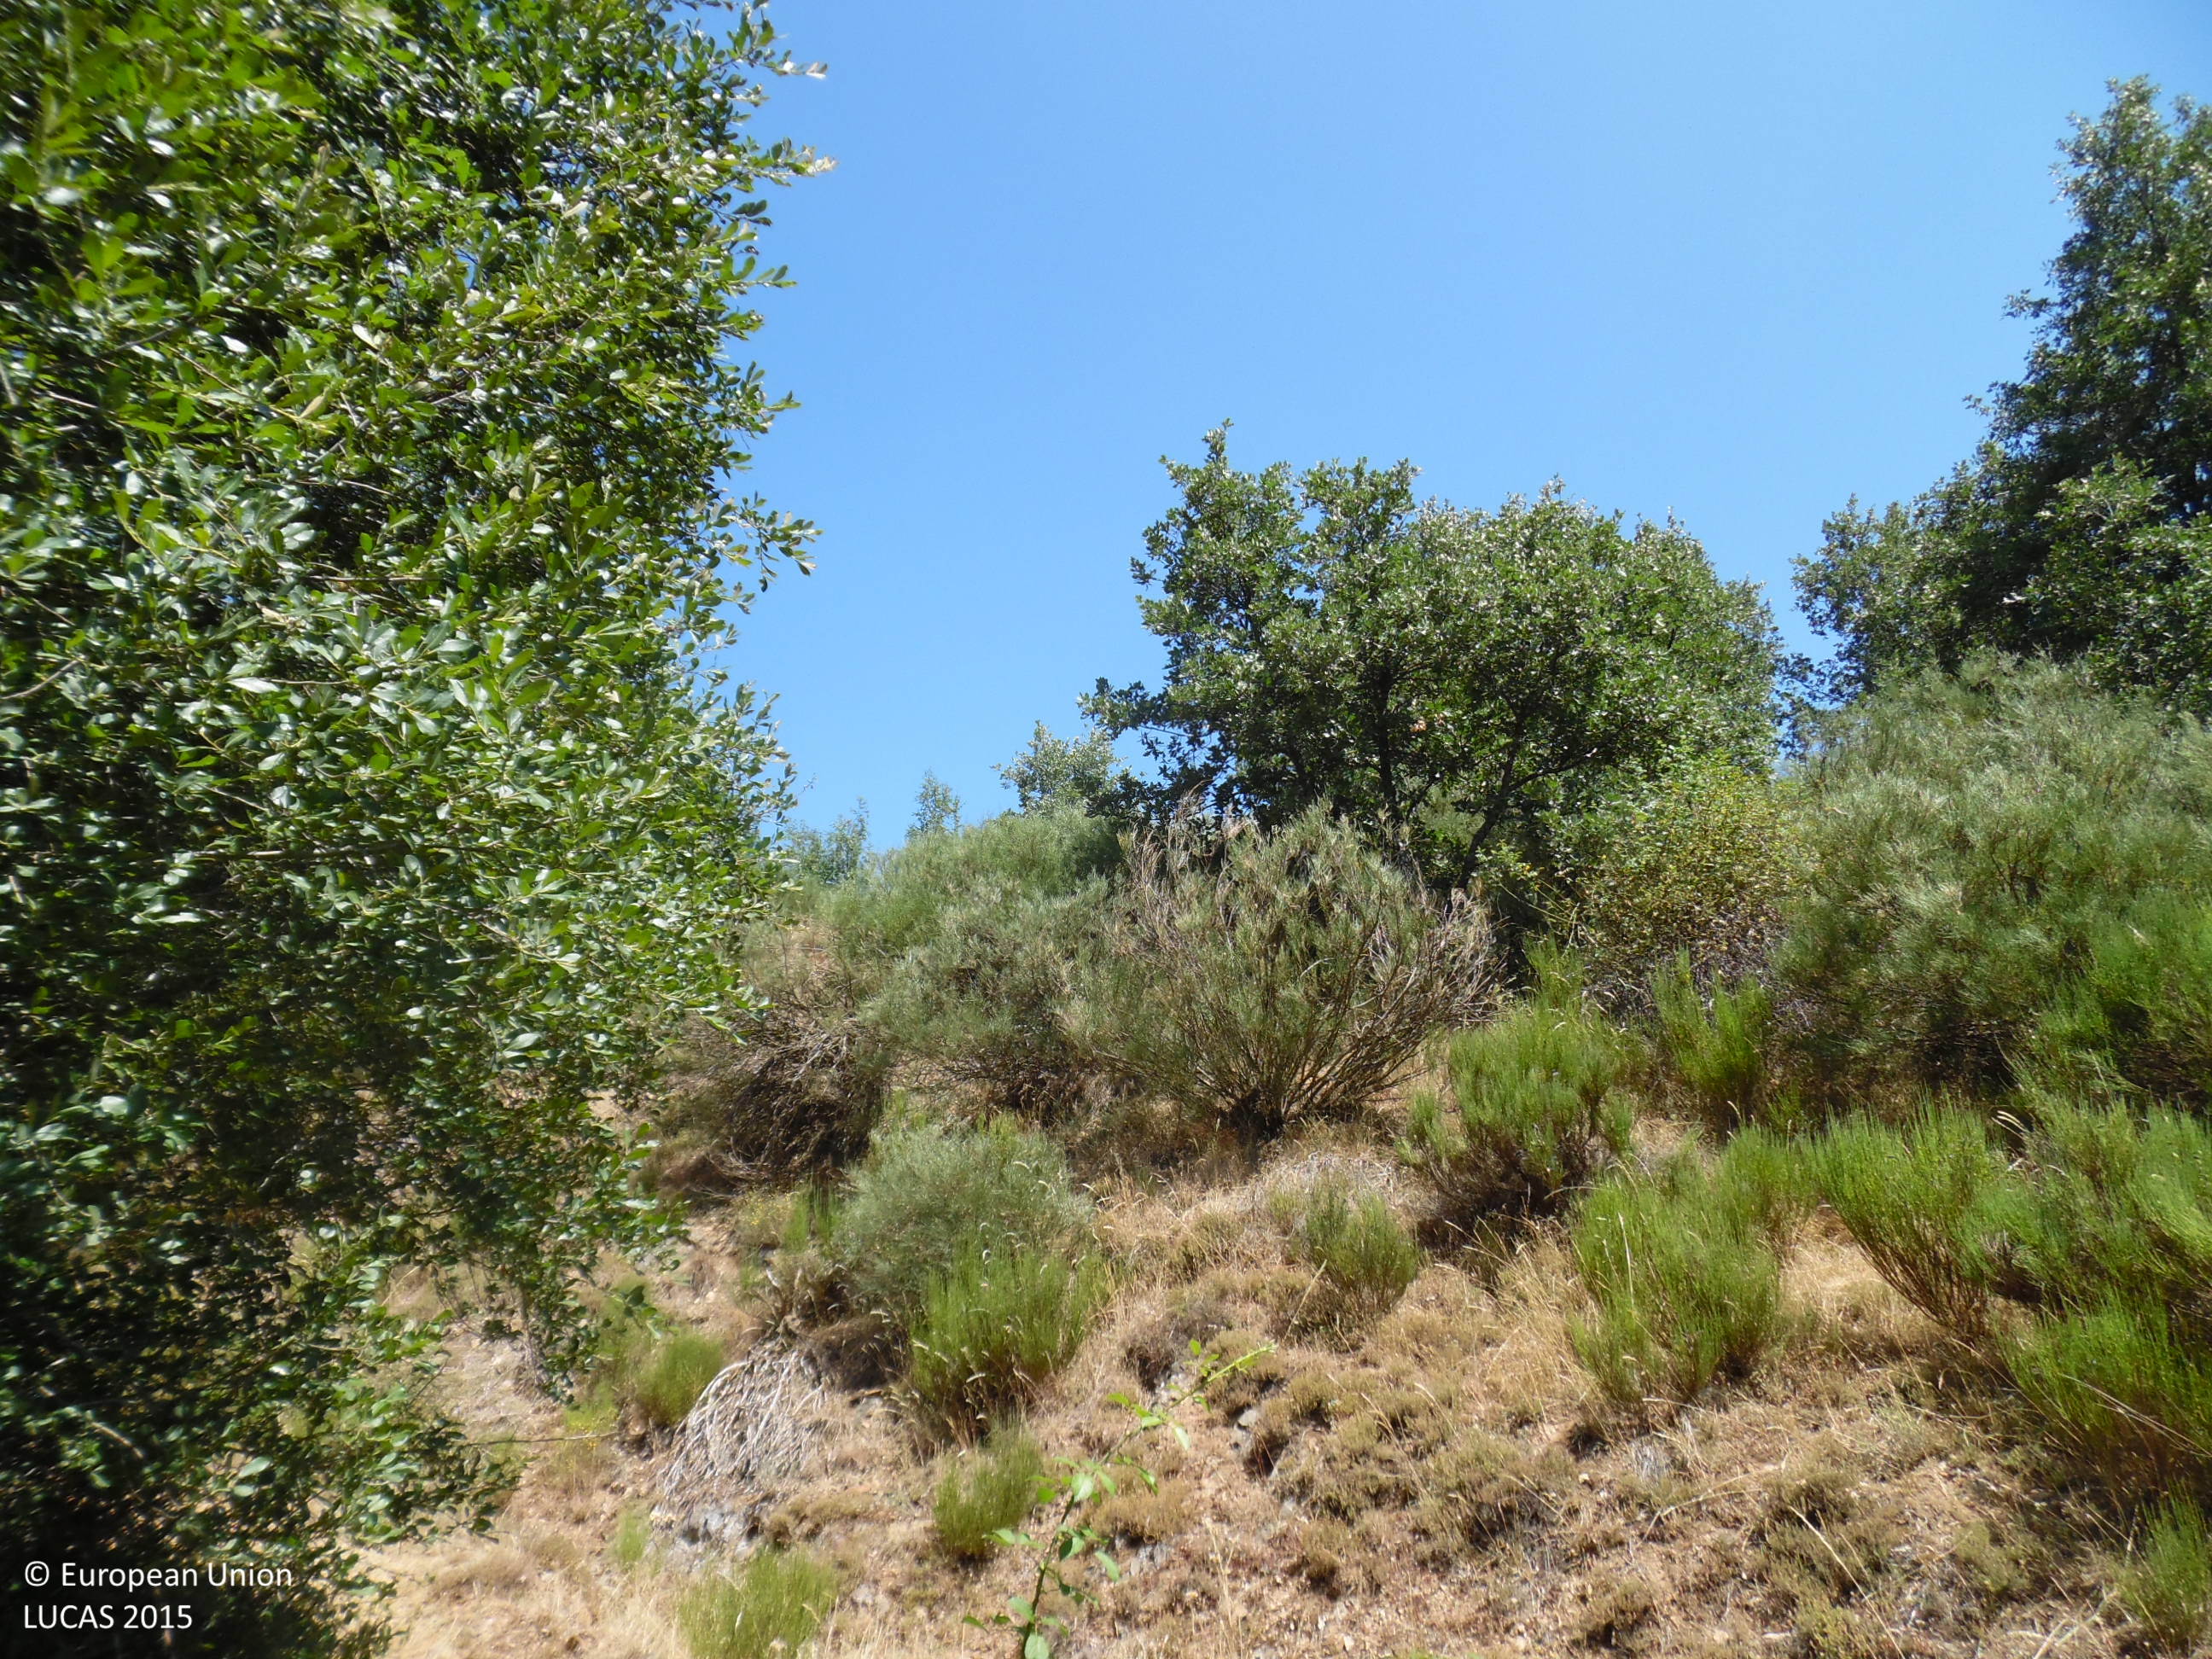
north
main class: Shrubland
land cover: Shrubland with sparse tree cover
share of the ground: > 75 %
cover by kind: shrubs 95 %, broadleaved forest trees 5 %
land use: Abandoned areas
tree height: > 5 m
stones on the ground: 10 - 25 %
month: July
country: ES
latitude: 42.8117
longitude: -5.8450
